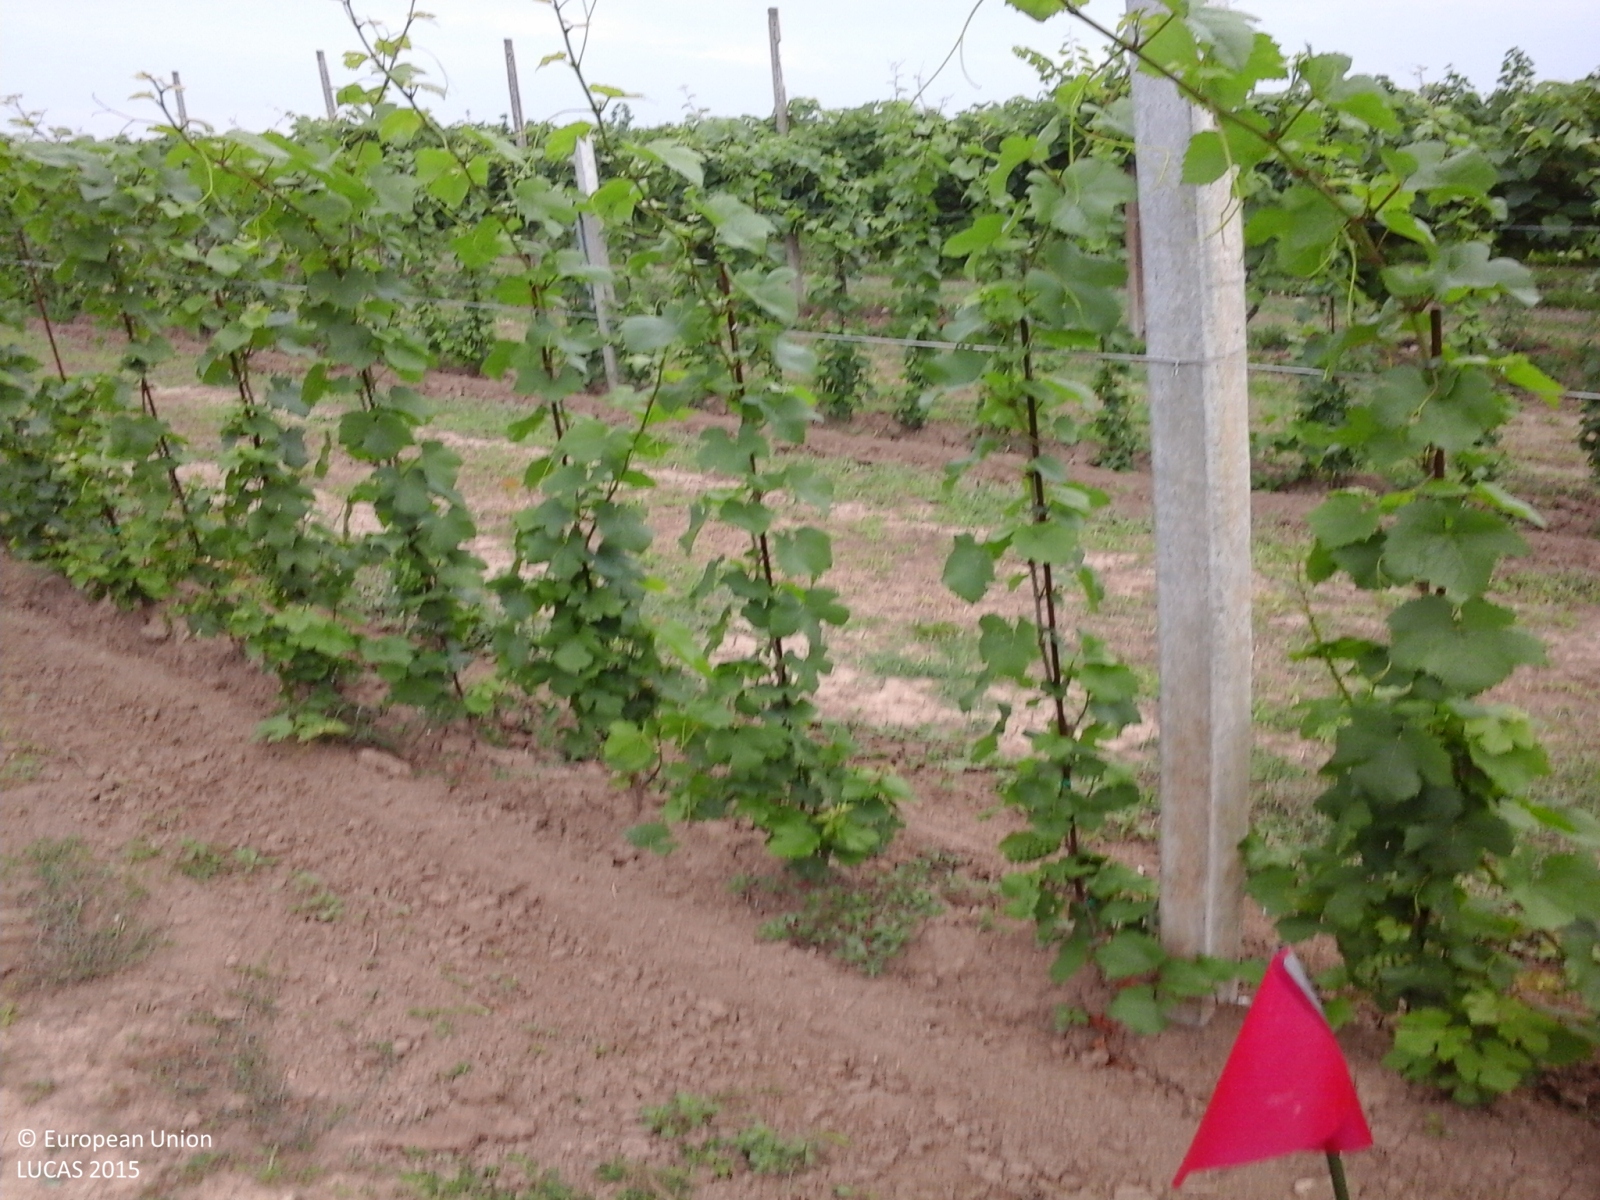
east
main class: Cropland
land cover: Vineyards
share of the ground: 50 - 75 %
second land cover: Grassland without tree/shrub cover
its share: 50 - 75 %
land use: Agriculture (excluding fallow land and kitchen gardens)
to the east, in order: Vineyards; Grassland without tree/shrub cover; Maize; Ditches and canals; Abandoned hedges; Vineyards; Grassland without tree/shrub cover; Ditches and canals
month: June
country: IT
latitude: 45.7656
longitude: 12.4011
